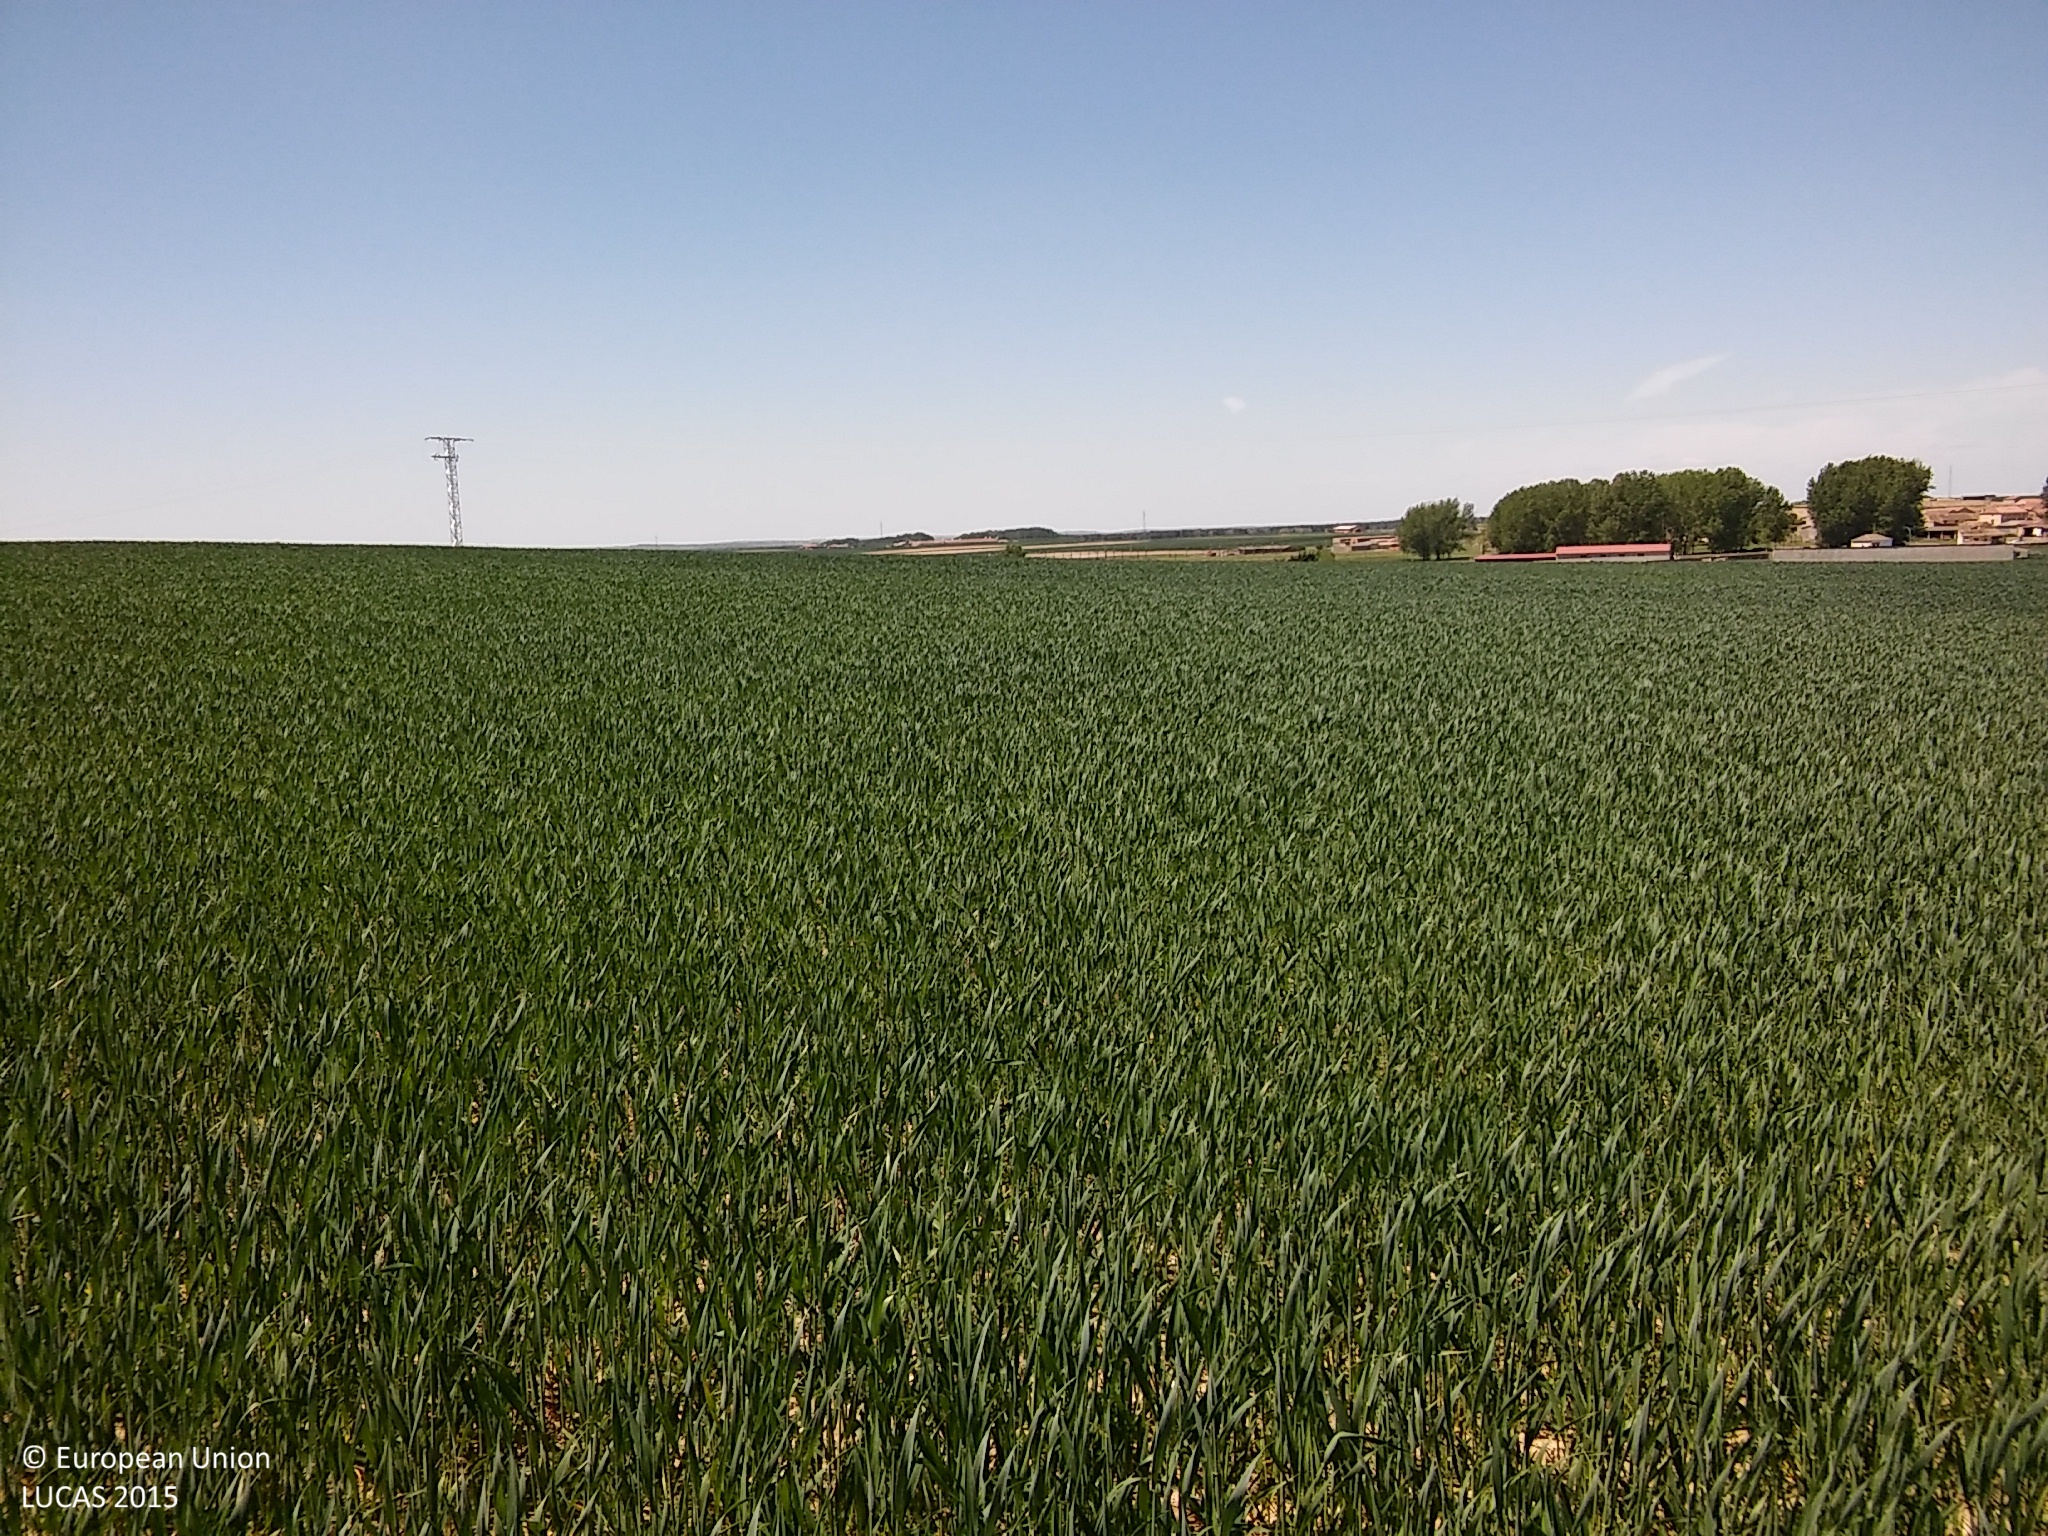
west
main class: Cropland
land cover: Common wheat
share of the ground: > 75 %
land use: Agriculture (excluding fallow land and kitchen gardens)
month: May
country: ES
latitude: 41.2291
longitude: -3.9254
